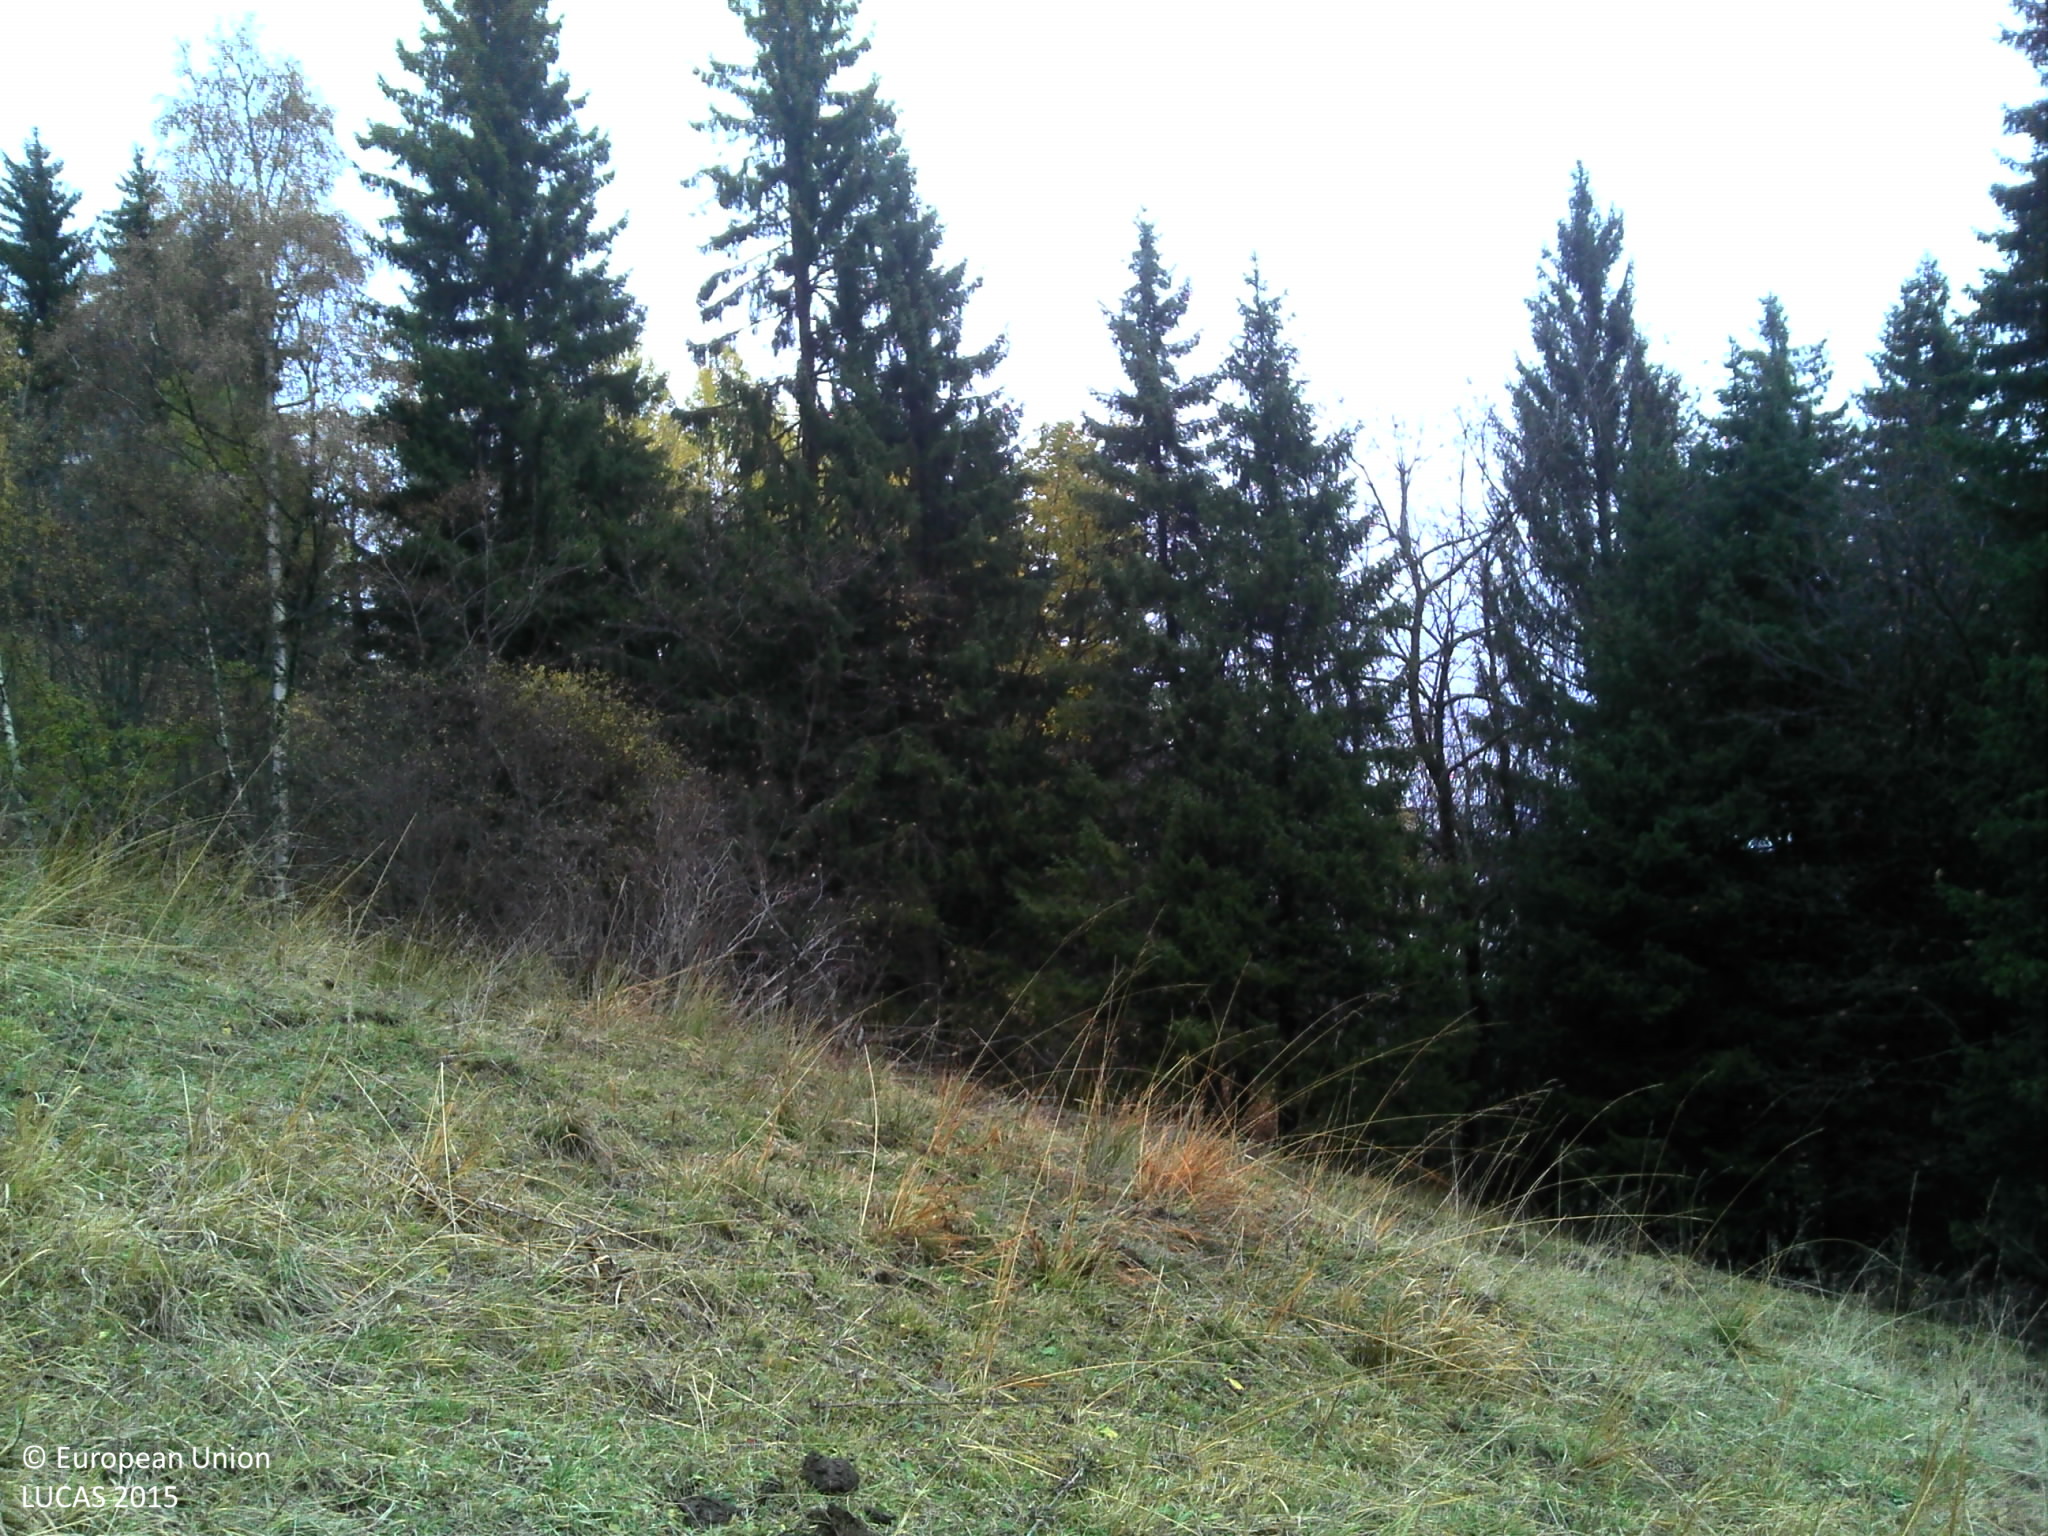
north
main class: Grassland
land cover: Grassland without tree/shrub cover
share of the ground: > 75 %
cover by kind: herbaceous plants 95 %, shrubs 5 %
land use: Agriculture (excluding fallow land and kitchen gardens)
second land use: Sport
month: October
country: FR
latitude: 45.4623
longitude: 6.4365
